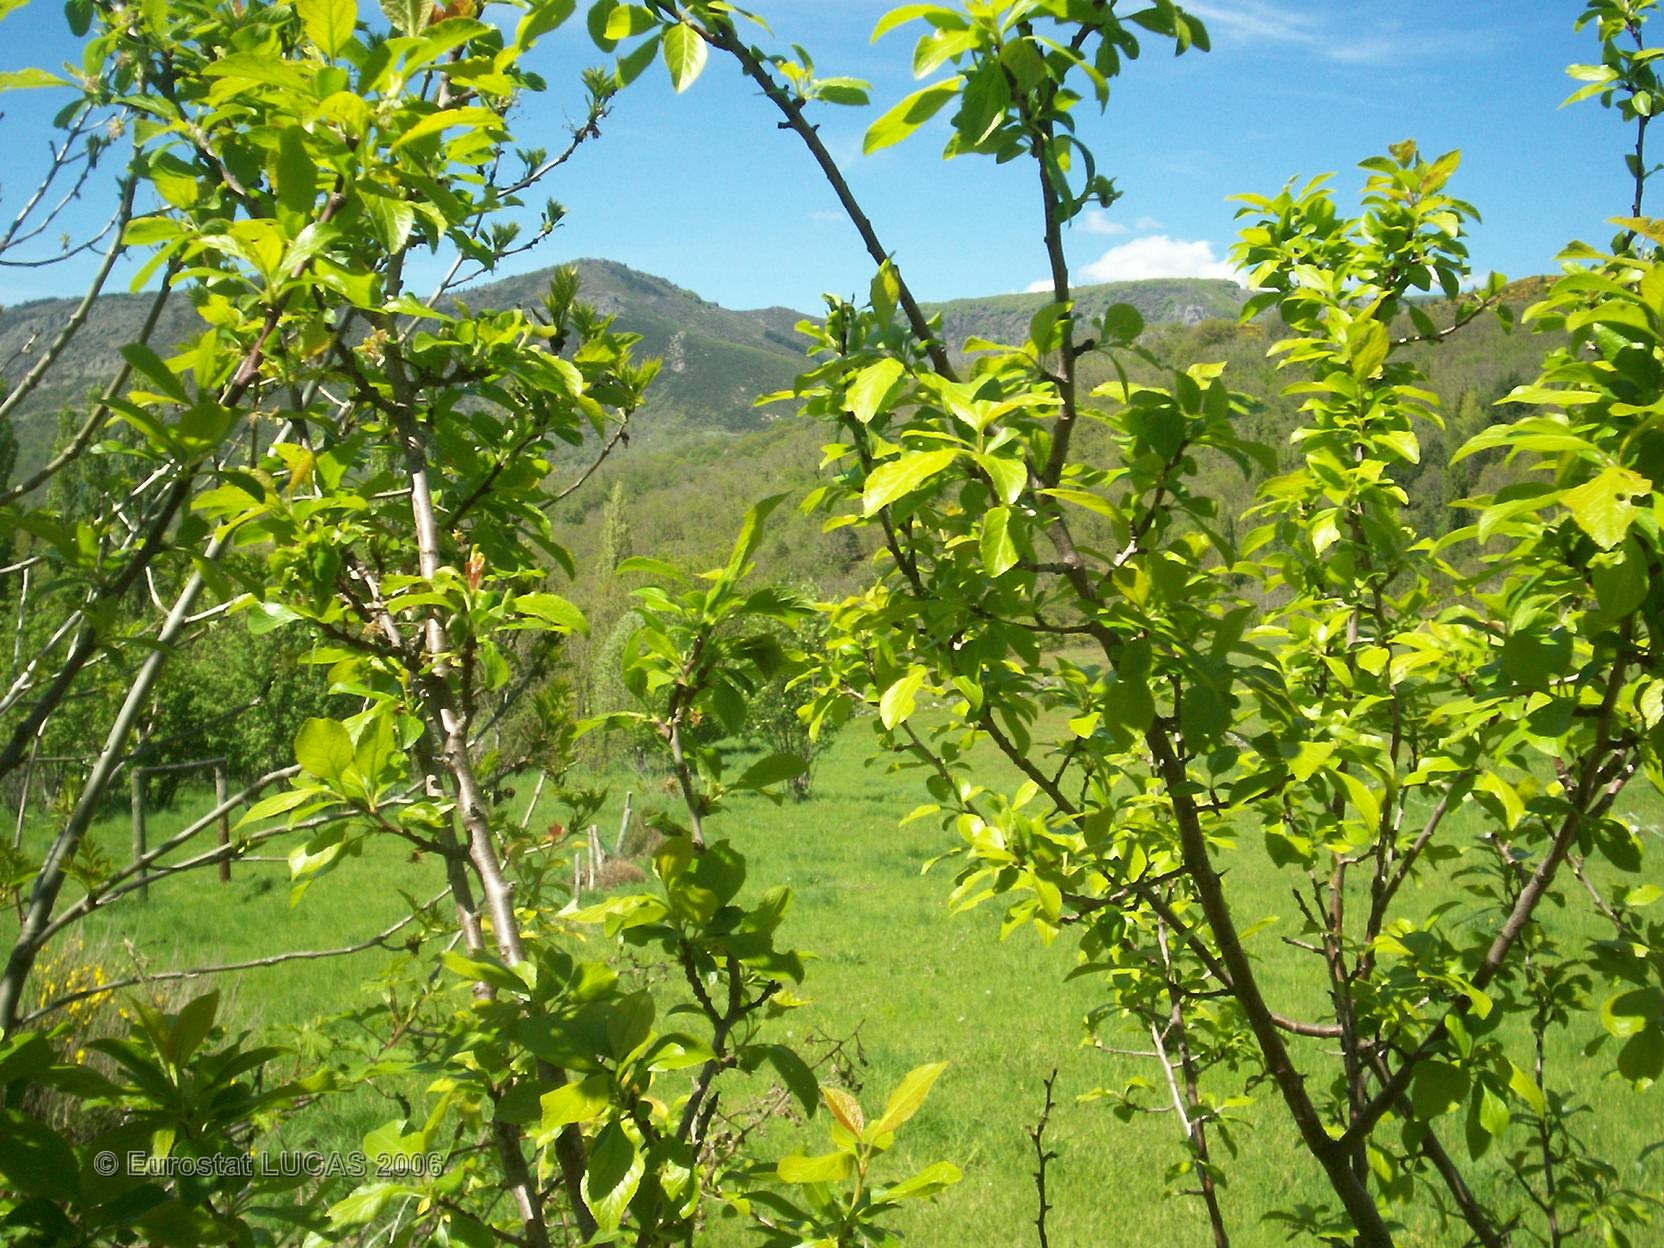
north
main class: Grassland
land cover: Grassland with sparse tree/shrub cover
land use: Unused
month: May
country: FR
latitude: 44.0517
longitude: 3.4290
